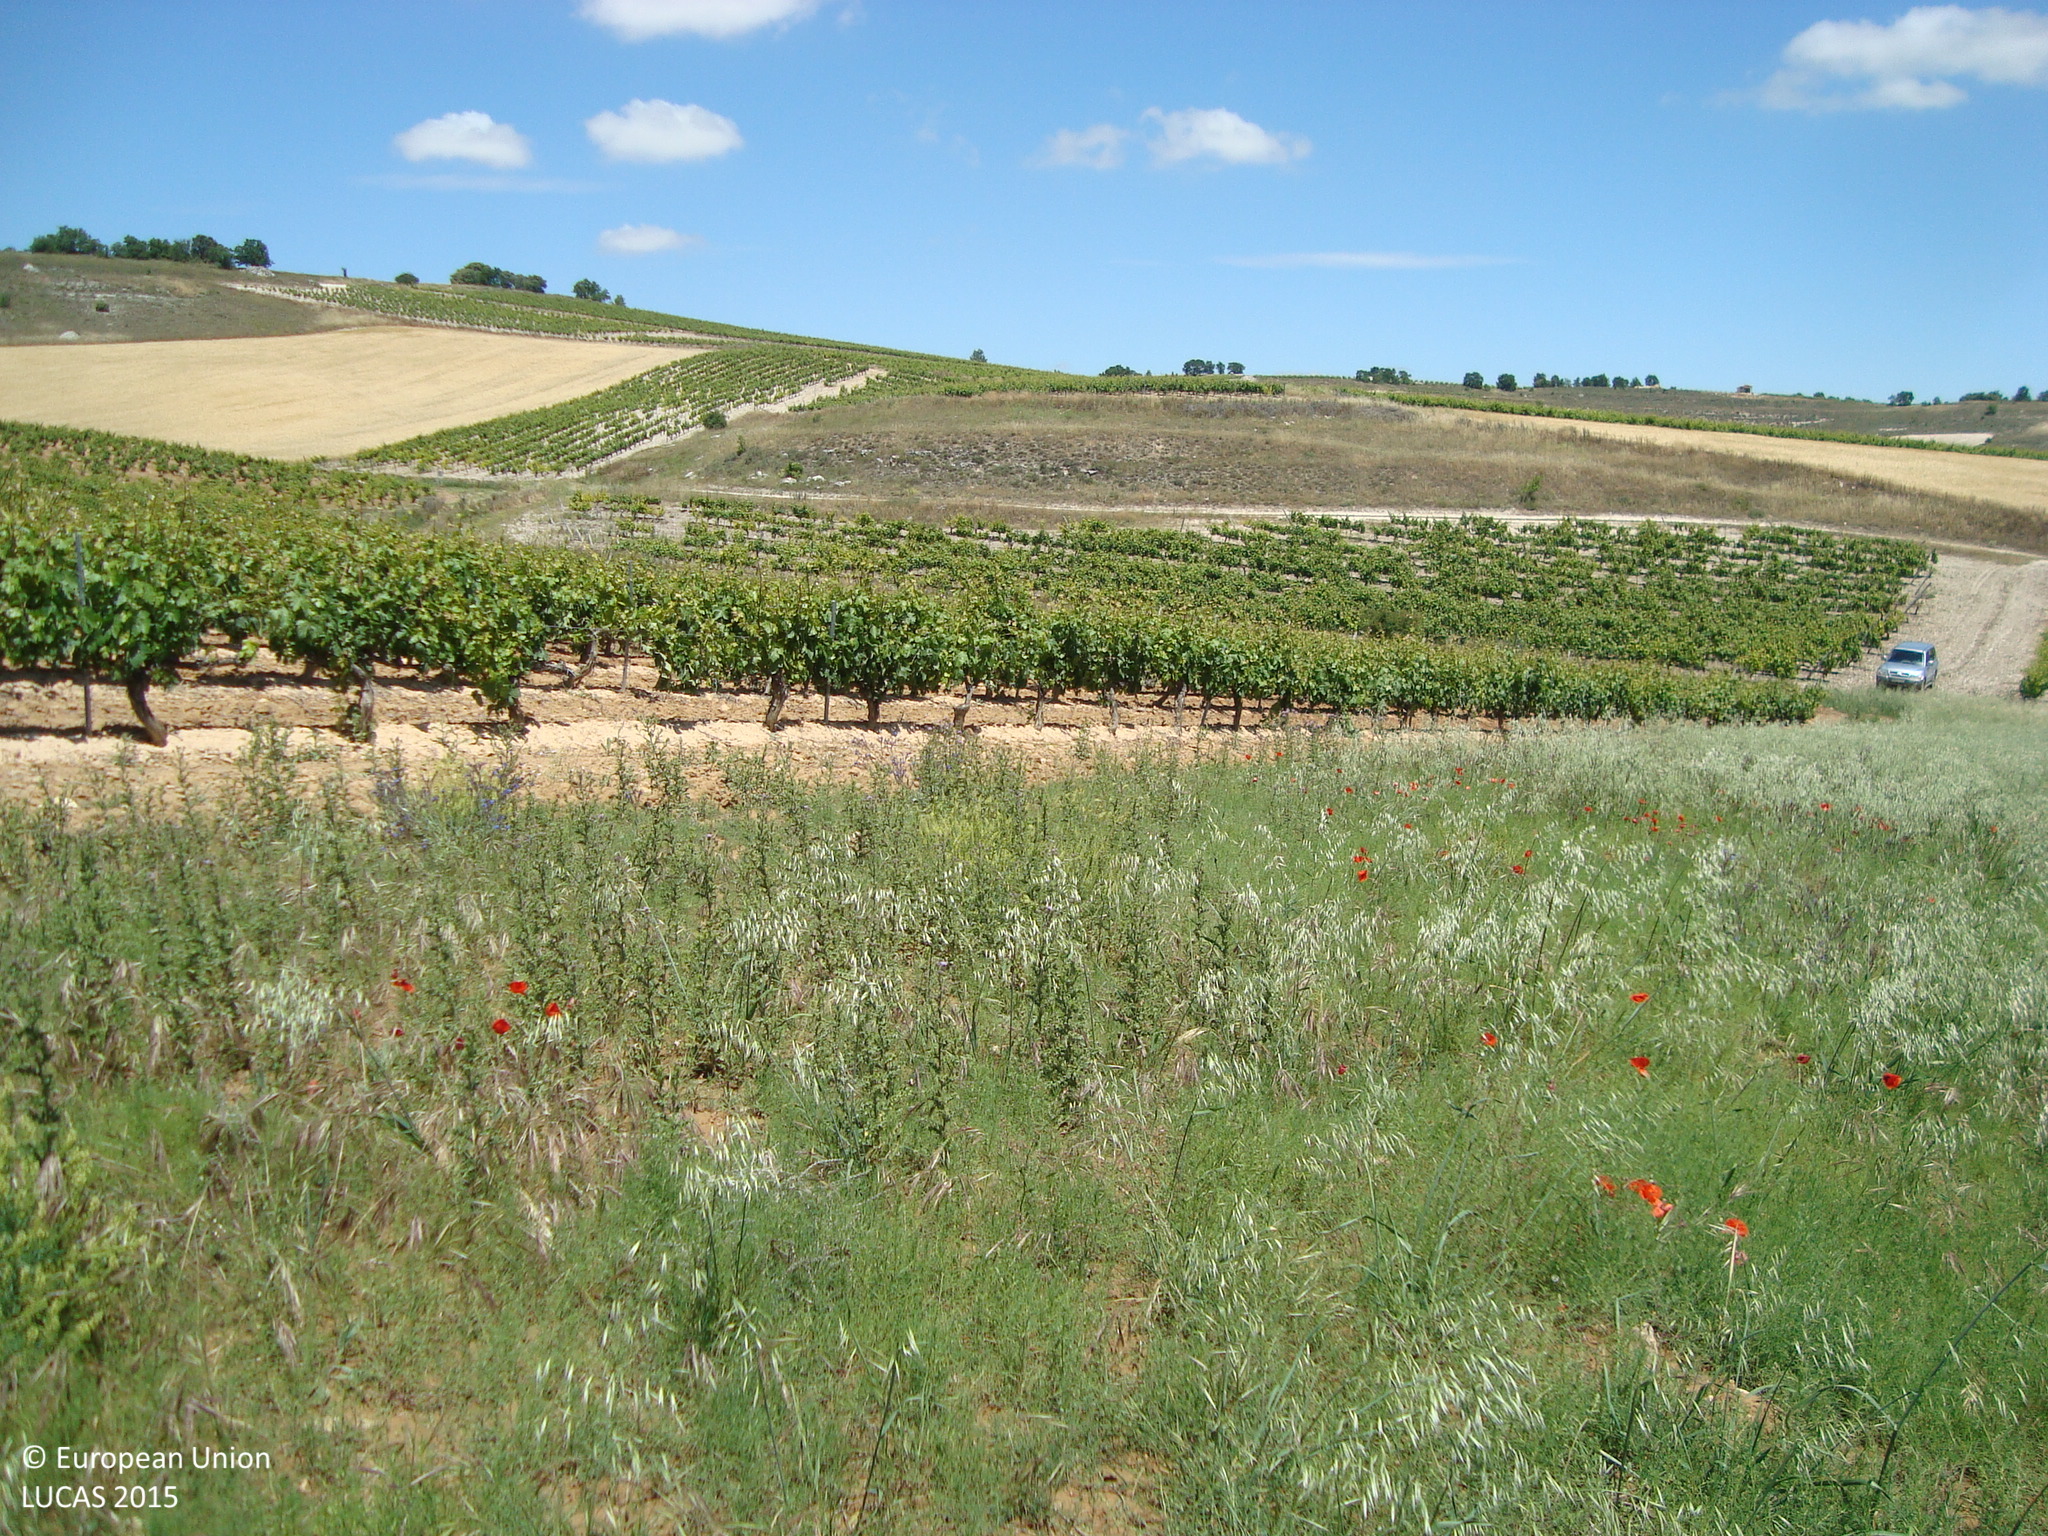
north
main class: Cropland
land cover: Oats
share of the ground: > 75 %
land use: Agriculture (excluding fallow land and kitchen gardens)
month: June
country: ES
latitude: 41.6666
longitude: -4.1966
